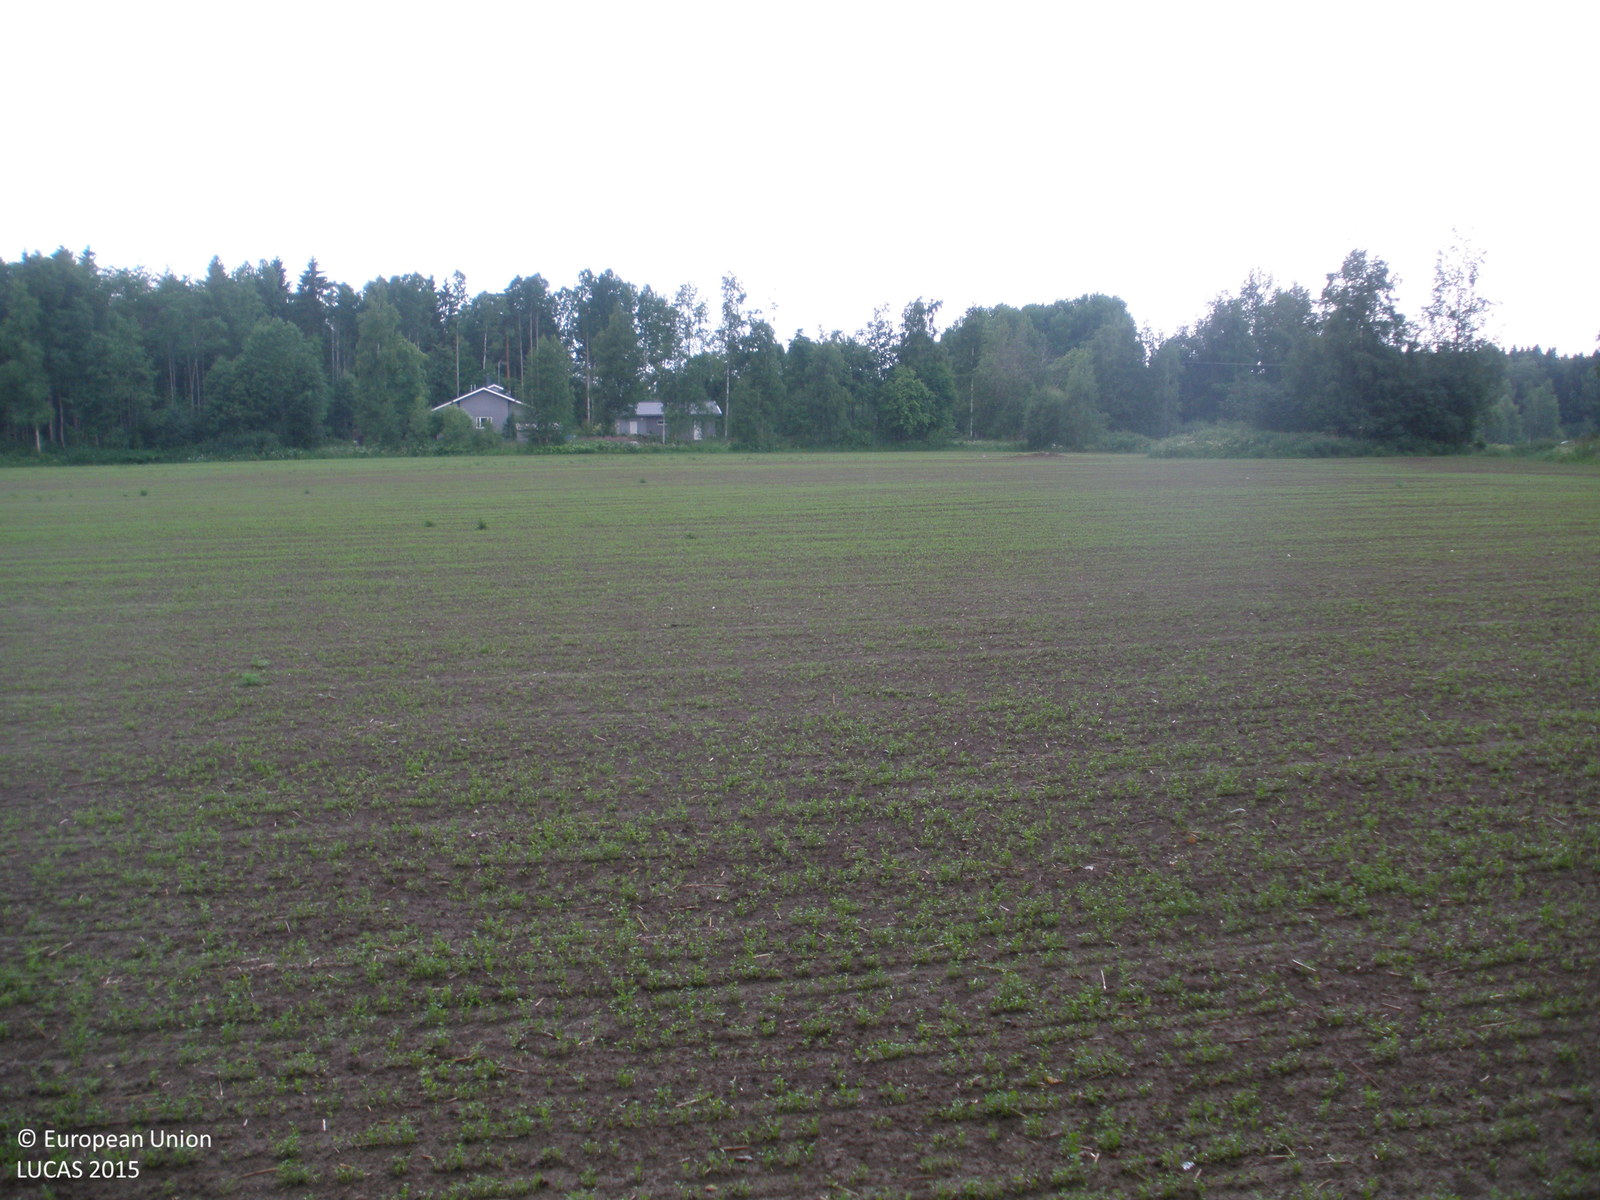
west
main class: Cropland
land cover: Other root crops
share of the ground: 25 - 50 %
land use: Agriculture (excluding fallow land and kitchen gardens)
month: July
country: FI
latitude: 61.4590
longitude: 23.9914
